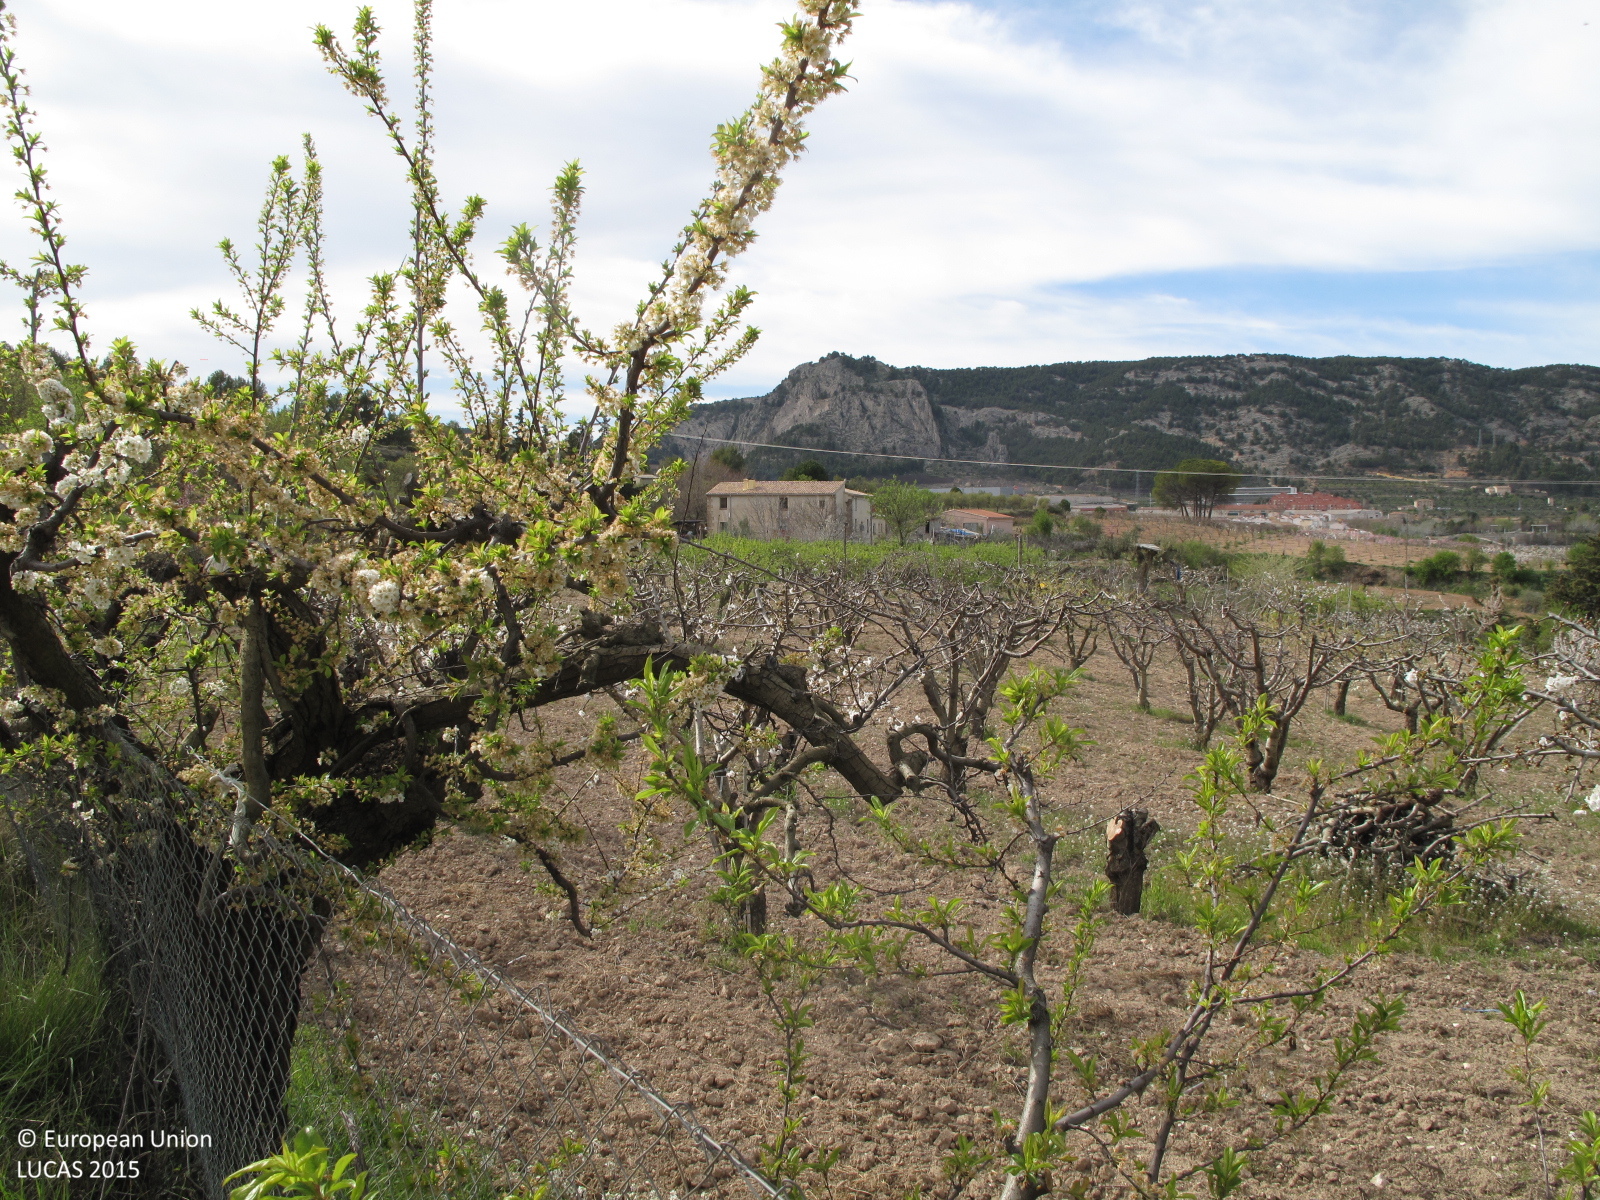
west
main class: Cropland
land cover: Cherry fruit
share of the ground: 25 - 50 %
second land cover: Other bare soil
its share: > 75 %
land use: Agriculture (excluding fallow land and kitchen gardens)
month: March
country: ES
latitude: 38.6824
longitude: -0.4845
